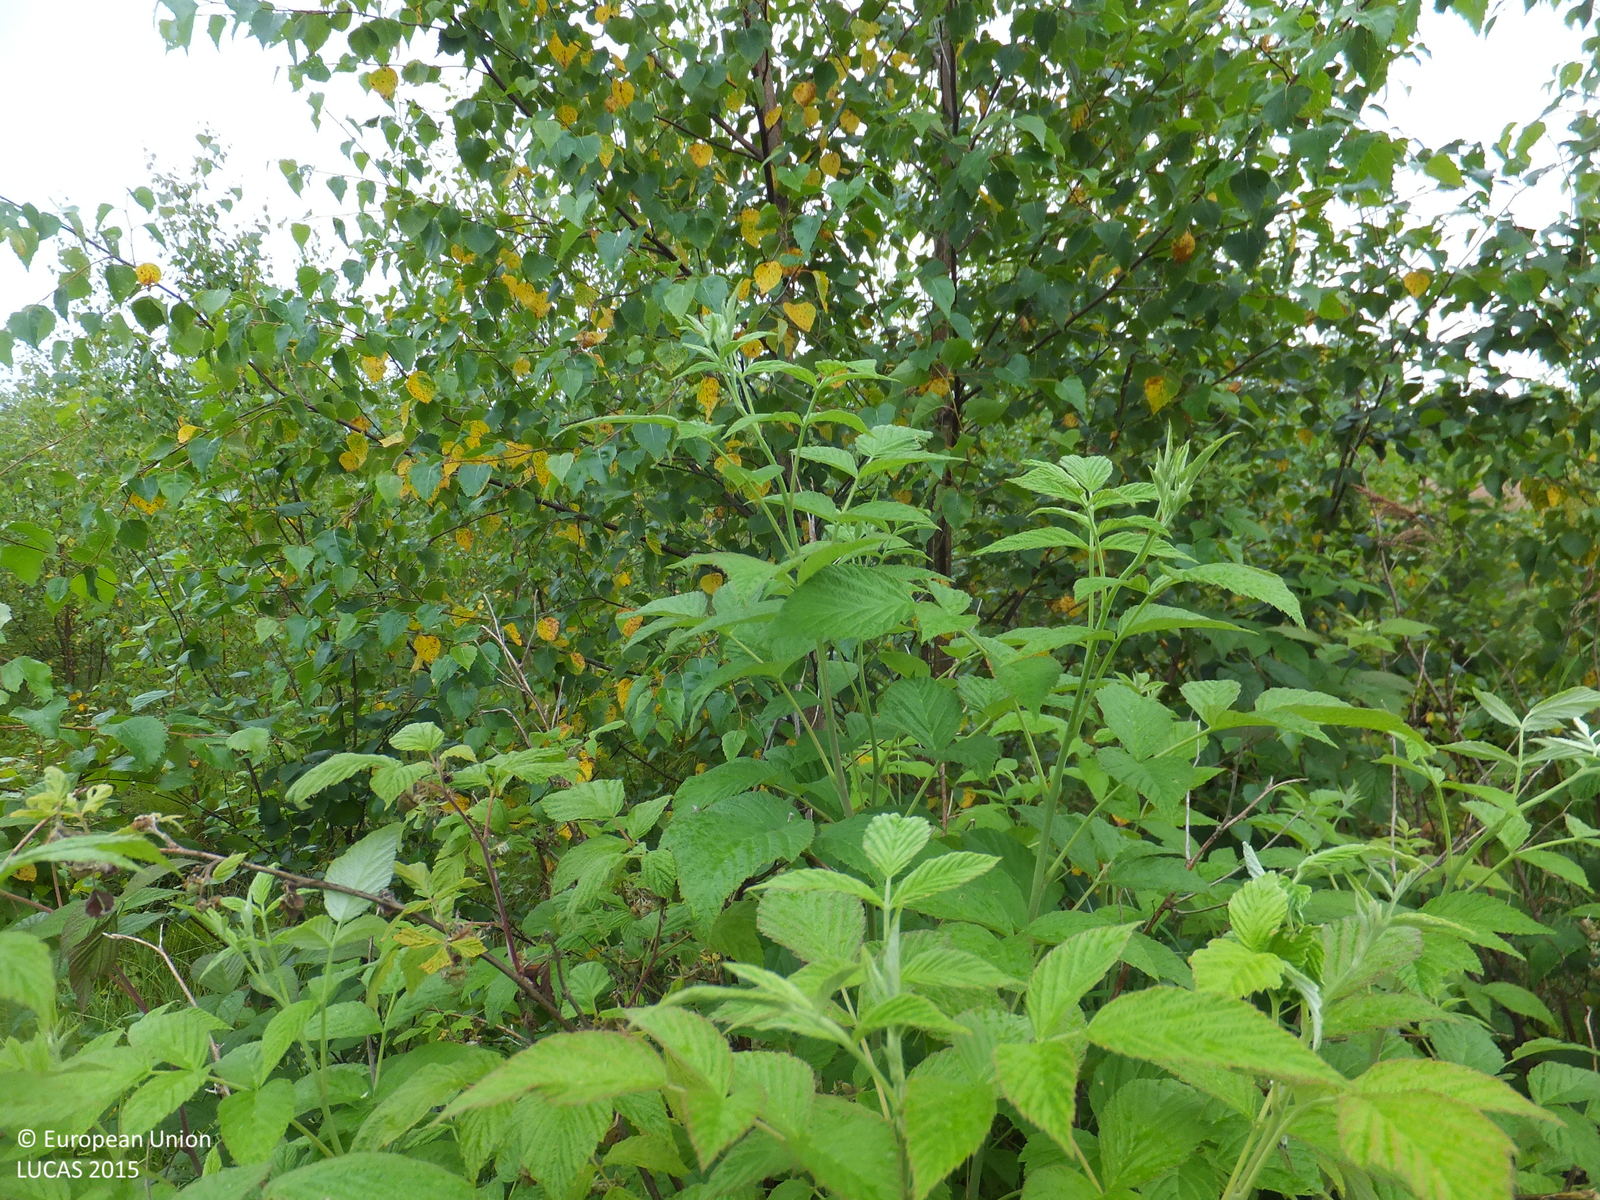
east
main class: Woodland
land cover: Pine dominated mixed woodland
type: boreal forest
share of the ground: > 75 %
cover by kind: coniferous forest trees 40 %, broadleaved forest trees 40 %, shrubs 10 %, herbaceous plants 10 %
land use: Forestry
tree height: < 5 m
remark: Nursery
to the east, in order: Pine dominated mixed woodland; Ditches and canals; Other mixed woodland; Ditches and canals; Grass margins; Paved roads, cycling and walking lanes; Spruce dominated coniferous woodland; Ditches and canals; Spruce dominated coniferous woodland; Ditches and canals; Spruce dominated coniferous woodland
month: July
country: FI
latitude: 63.1033
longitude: 21.9518
